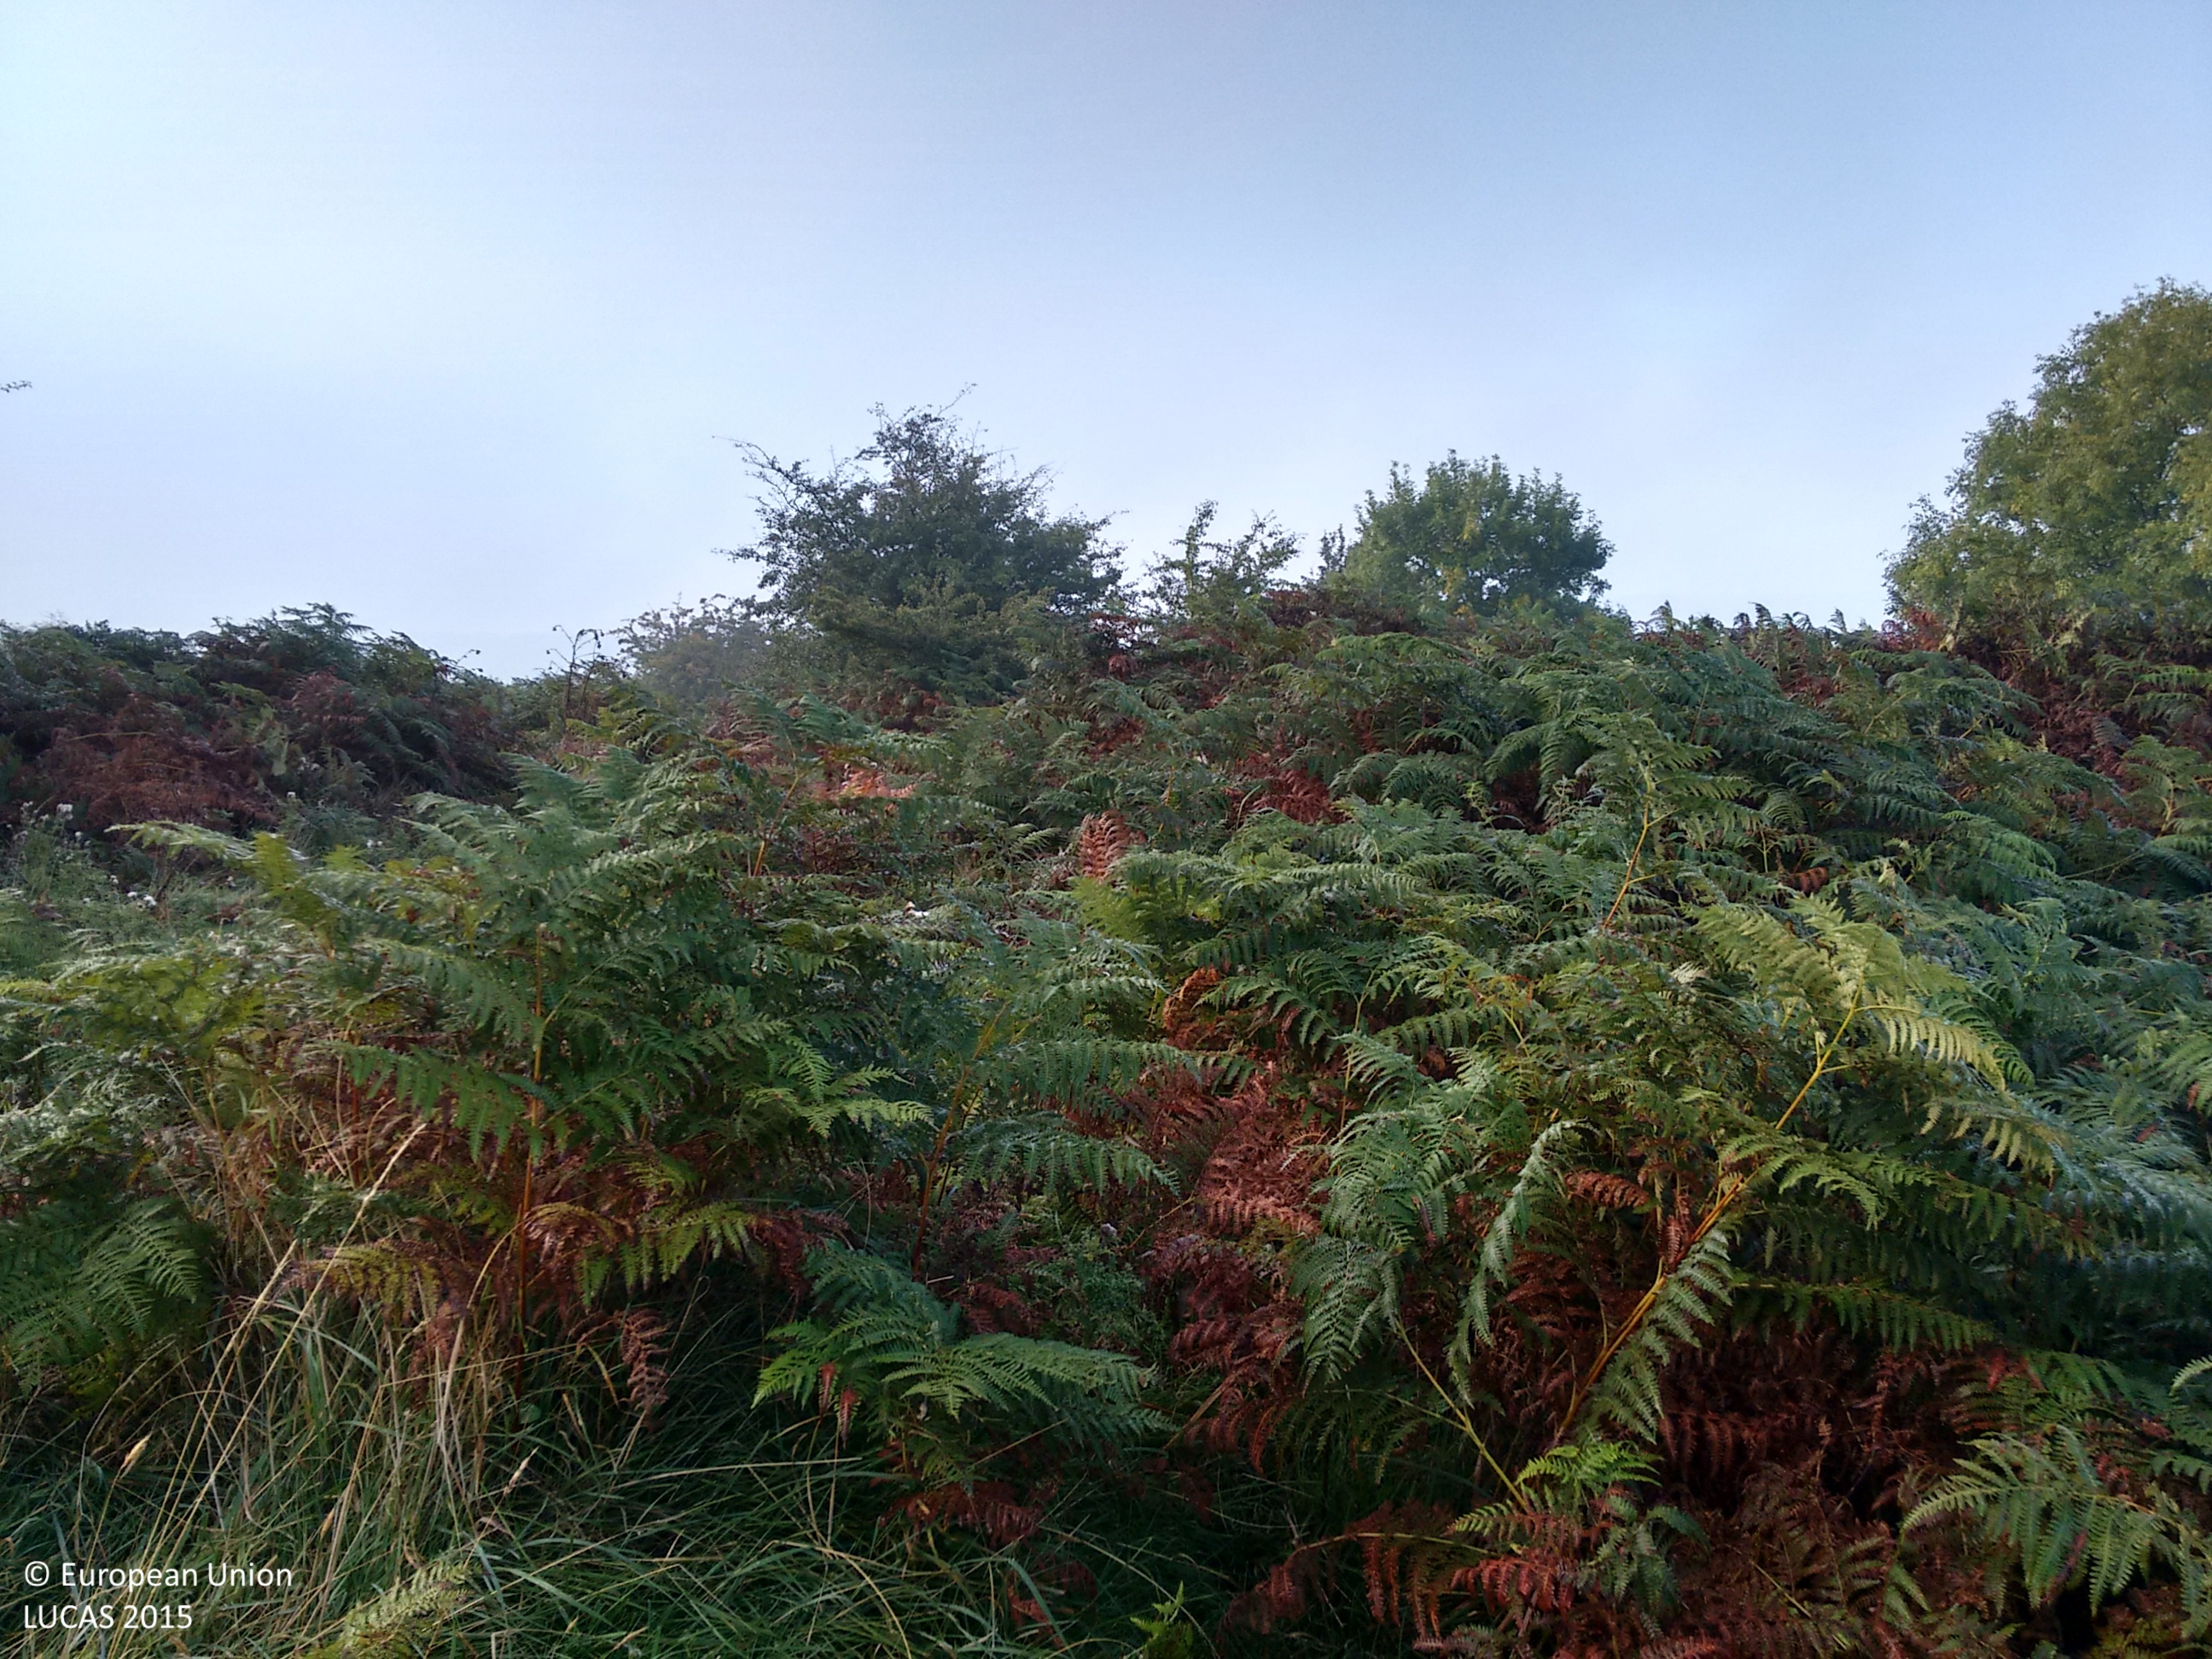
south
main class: Shrubland
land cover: Shrubland with sparse tree cover
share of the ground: > 75 %
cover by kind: herbaceous plants 60 %, shrubs 35 %, broadleaved forest trees 5 %
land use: Agriculture (excluding fallow land and kitchen gardens)
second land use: Community services
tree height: < 5 m
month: September
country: GB
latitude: 51.9270
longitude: -2.0270
